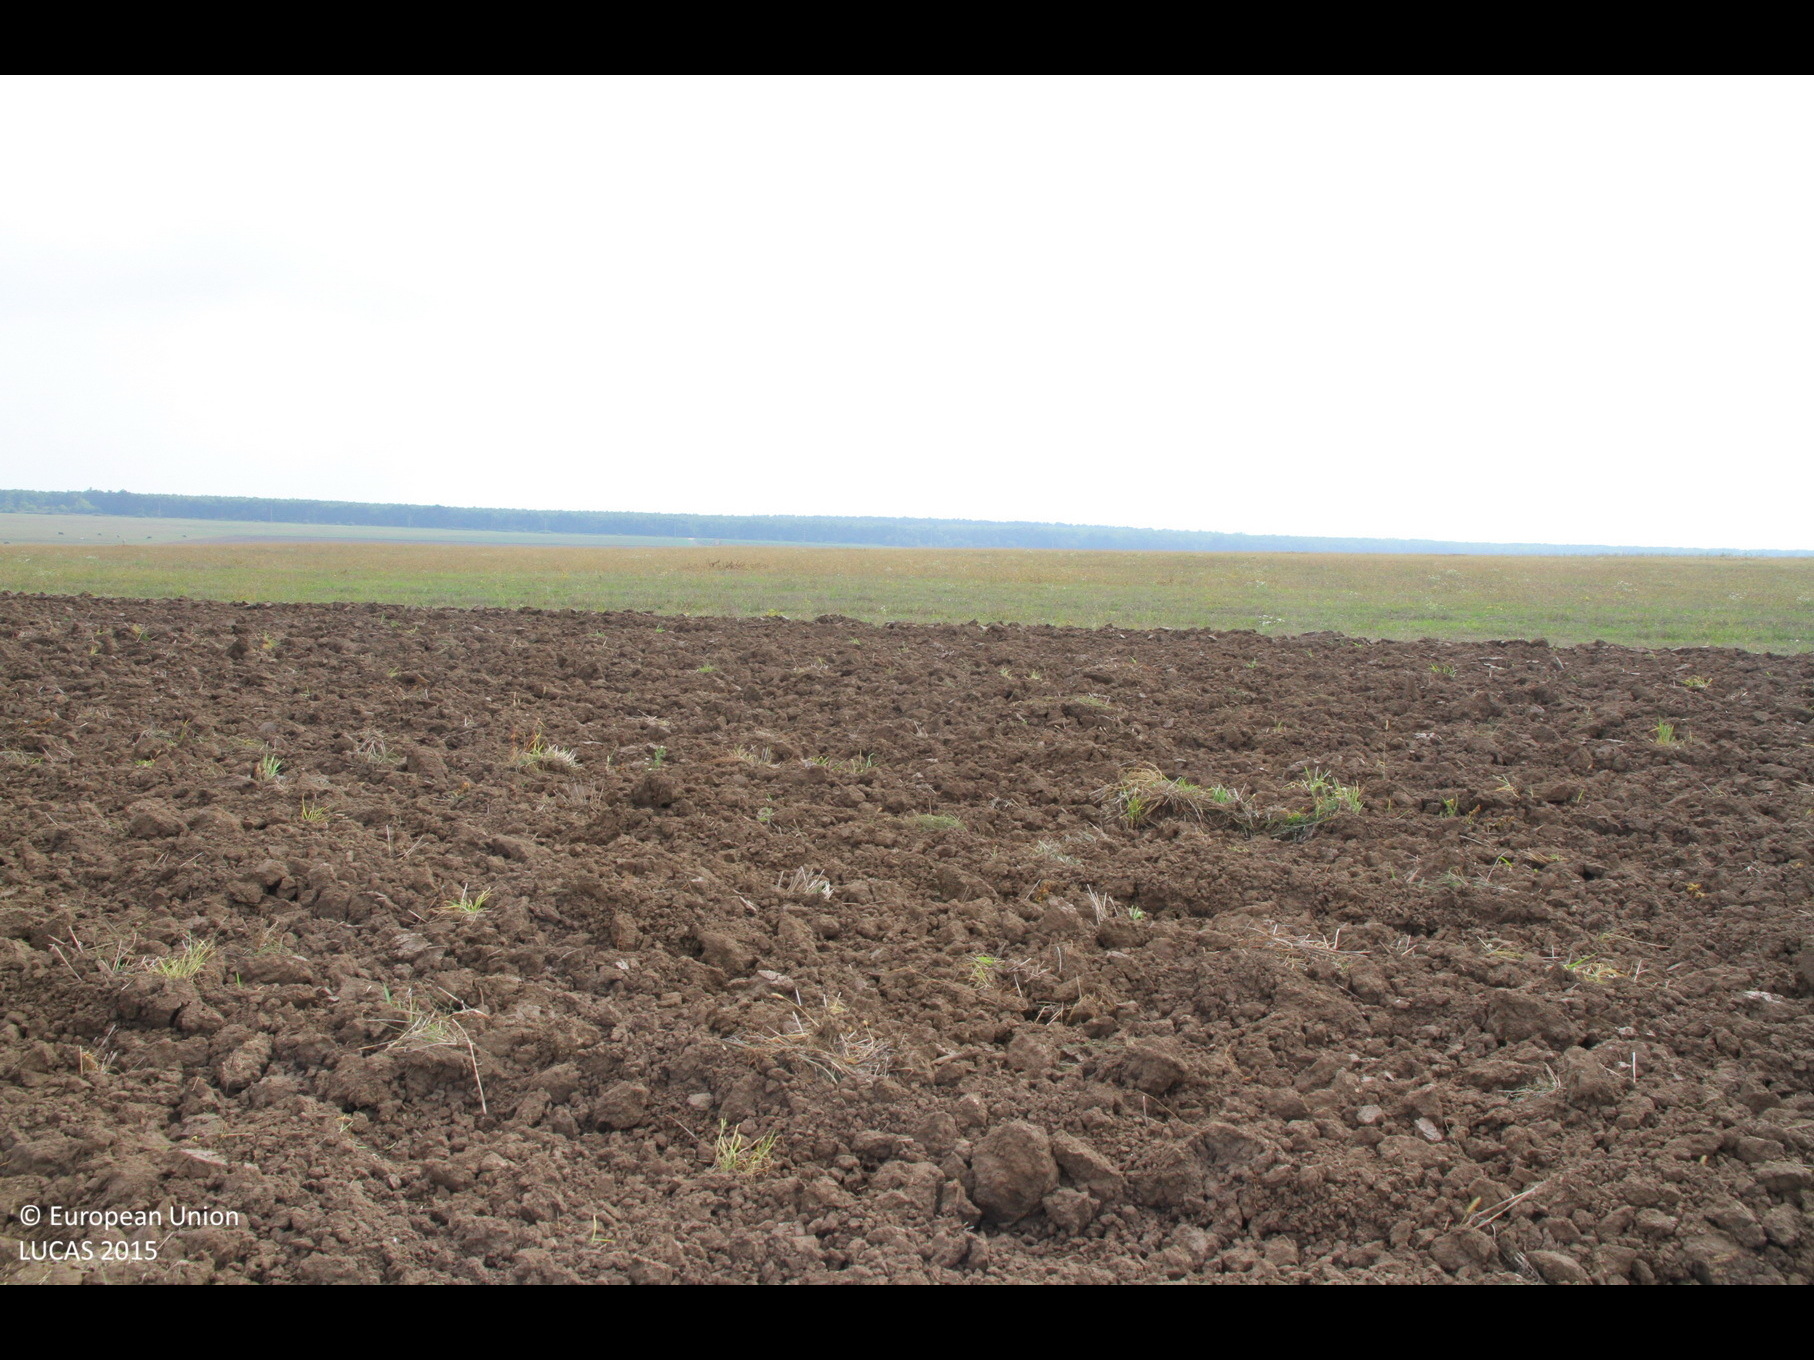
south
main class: Cropland
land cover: Common wheat
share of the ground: < 10 %
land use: Agriculture (excluding fallow land and kitchen gardens)
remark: Harvested field
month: October
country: BG
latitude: 43.6066
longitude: 27.0564
